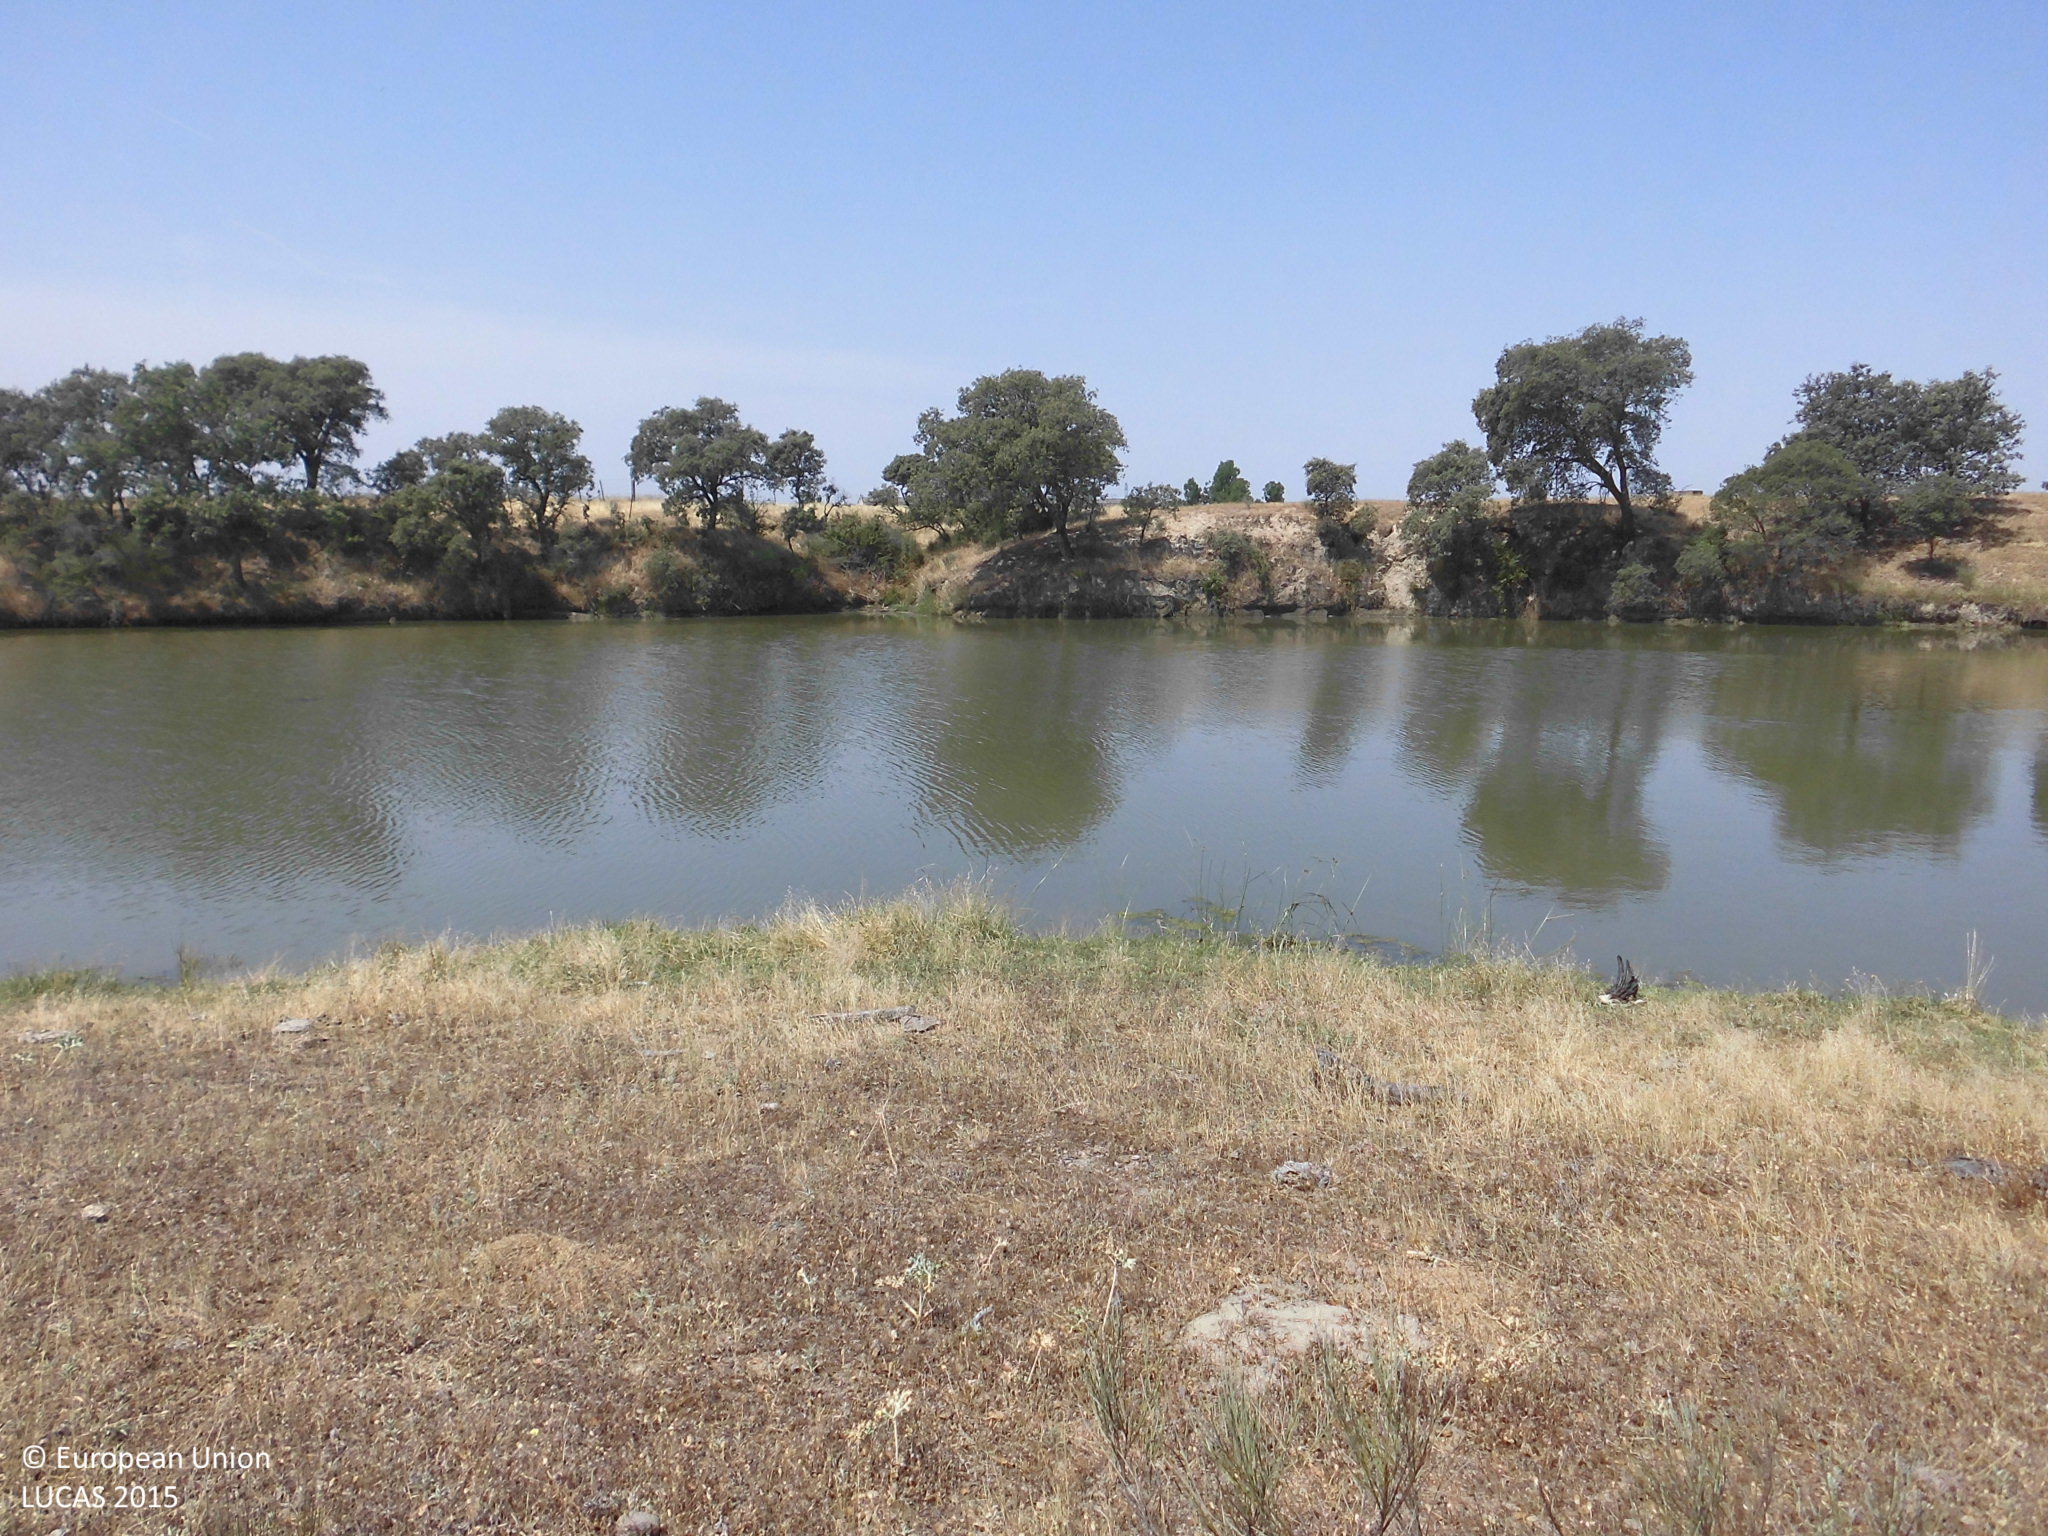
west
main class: Woodland
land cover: Broadleaved woodland
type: broadleaved evergreen forest
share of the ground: 10 - 25 %
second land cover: Grassland without tree/shrub cover
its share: > 75 %
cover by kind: herbaceous plants 80 %, broadleaved forest trees 15 %, consolidated bare surface 5 %
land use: Forestry
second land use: Agriculture (excluding fallow land and kitchen gardens)
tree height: > 5 m
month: June
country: ES
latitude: 39.9032
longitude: -5.6529
